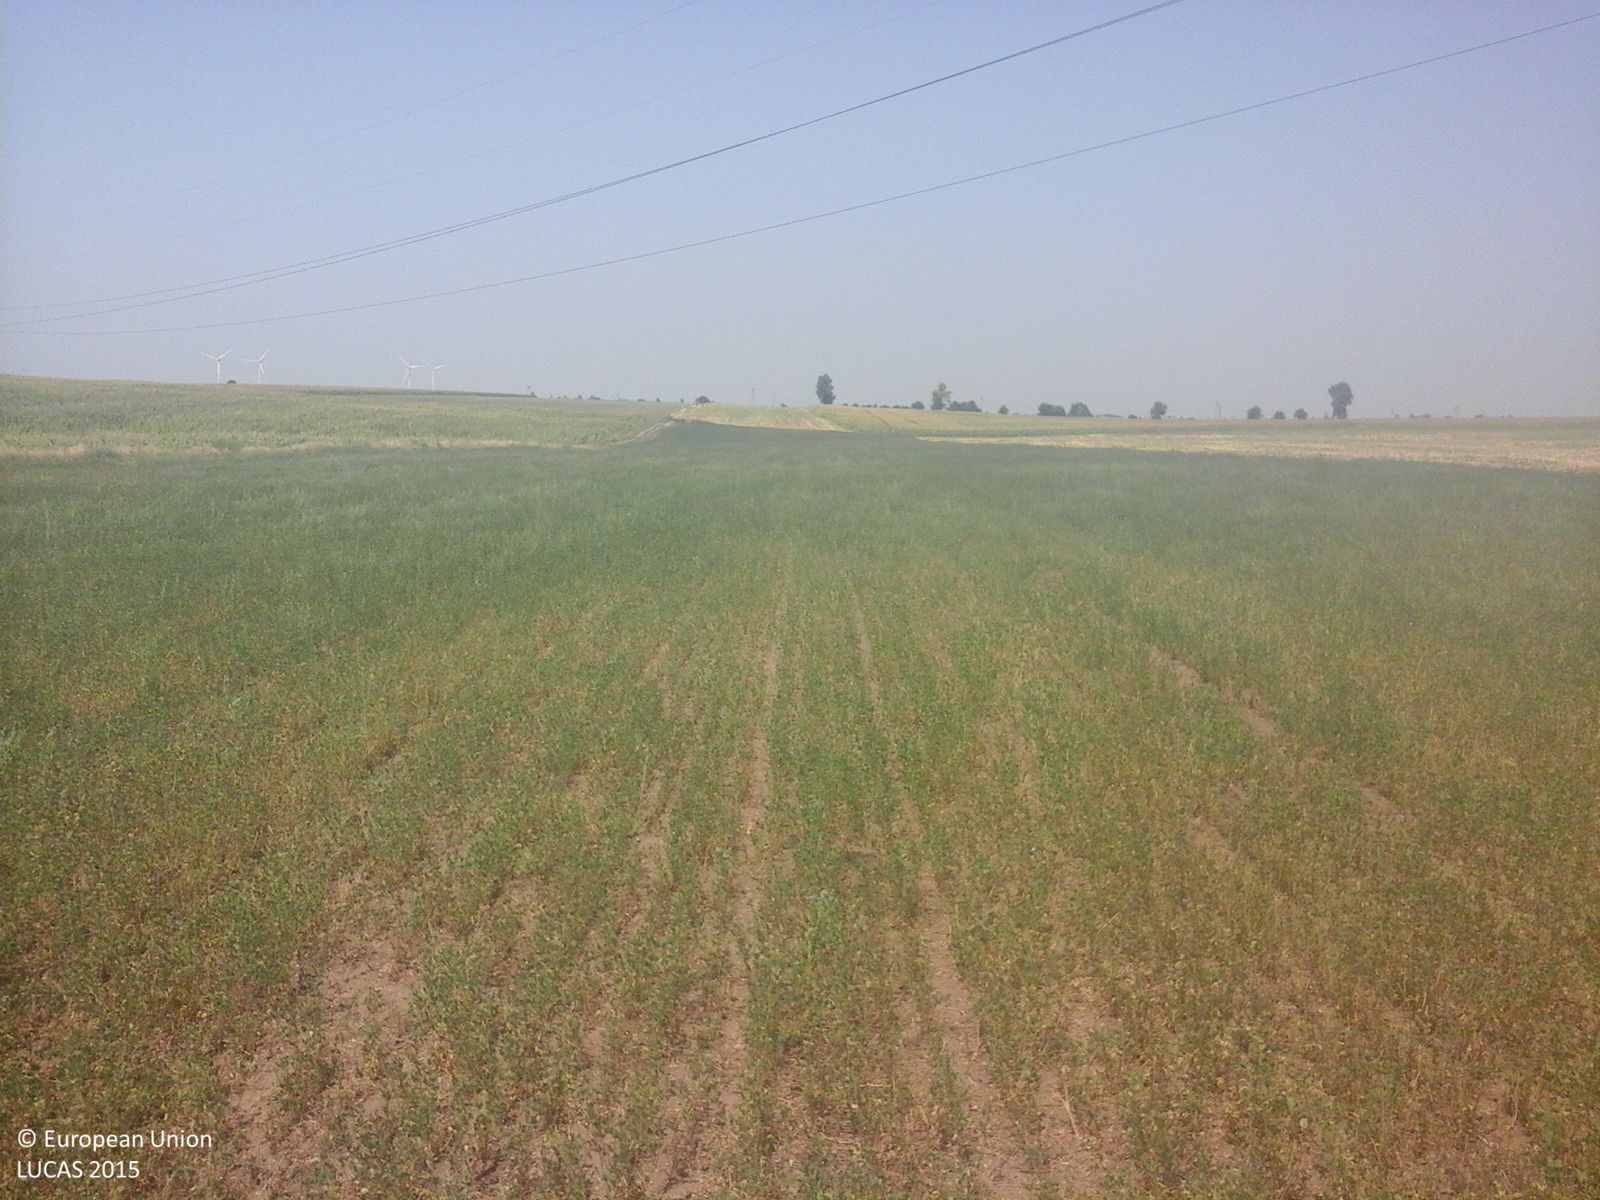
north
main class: Cropland
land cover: Lucerne
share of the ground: > 75 %
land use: Agriculture (excluding fallow land and kitchen gardens)
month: July
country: RO
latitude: 45.4953
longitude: 27.8622
